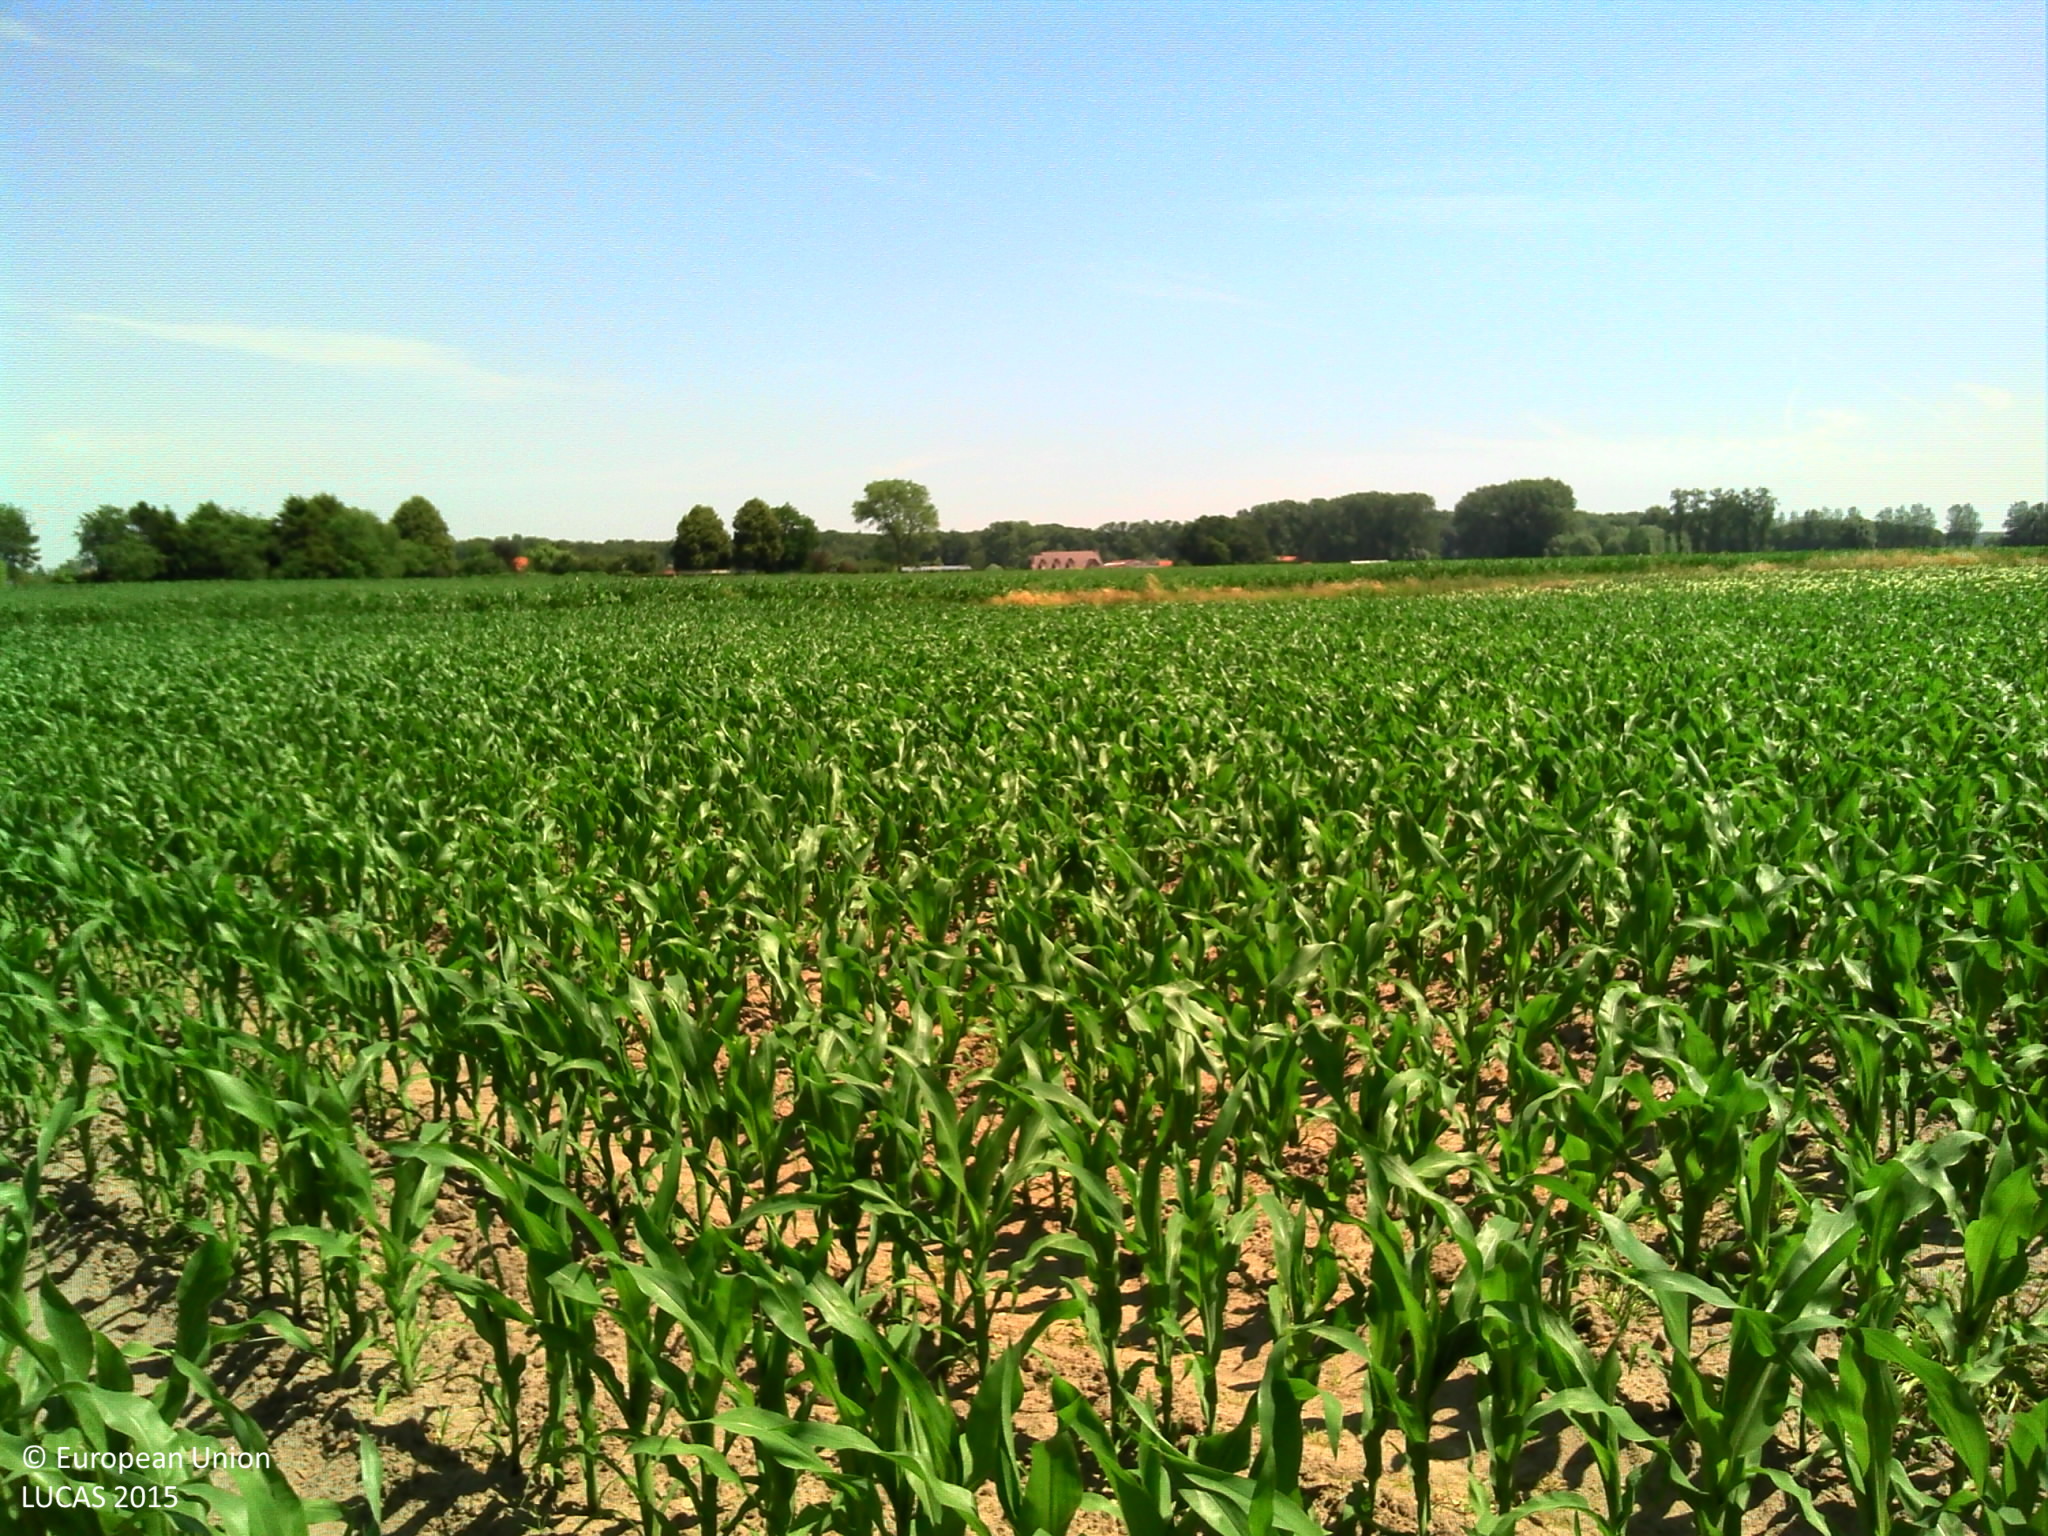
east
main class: Cropland
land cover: Maize
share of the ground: > 75 %
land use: Agriculture (excluding fallow land and kitchen gardens)
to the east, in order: Maize; Grass margins; Tracks; Grass margins; Maize; Ditches and canals; Potatoes
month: July
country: BE
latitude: 51.1314
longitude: 3.4327
